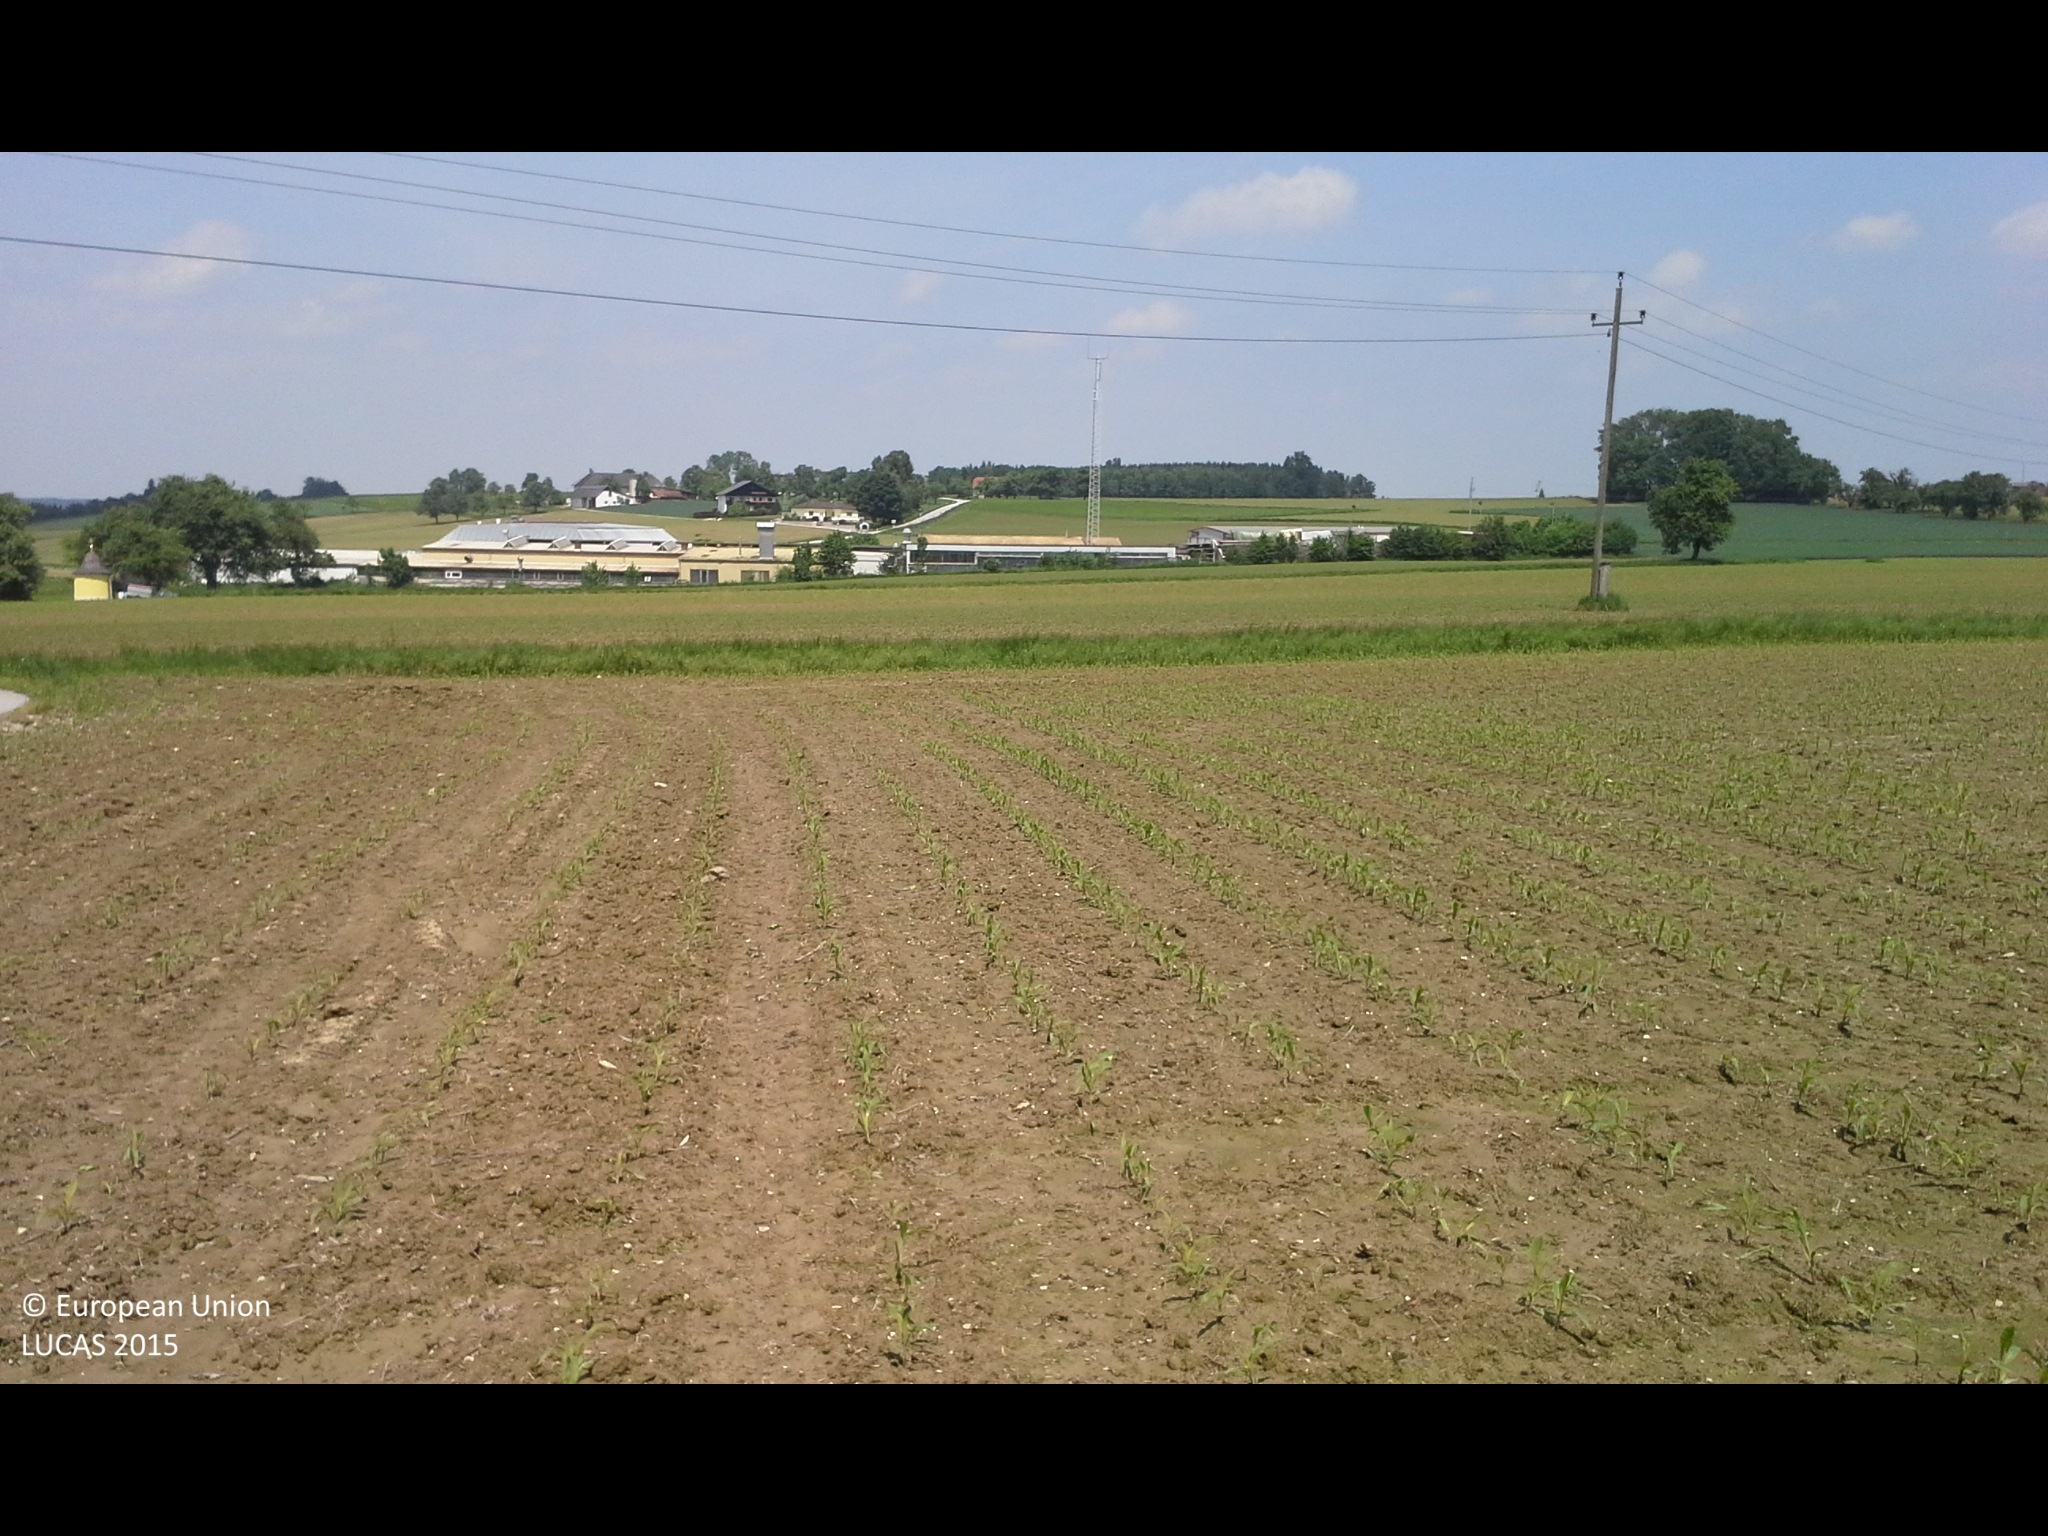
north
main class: Cropland
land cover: Maize
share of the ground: 10 - 25 %
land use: Agriculture (excluding fallow land and kitchen gardens)
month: May
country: AT
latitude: 47.9986
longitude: 14.2213
